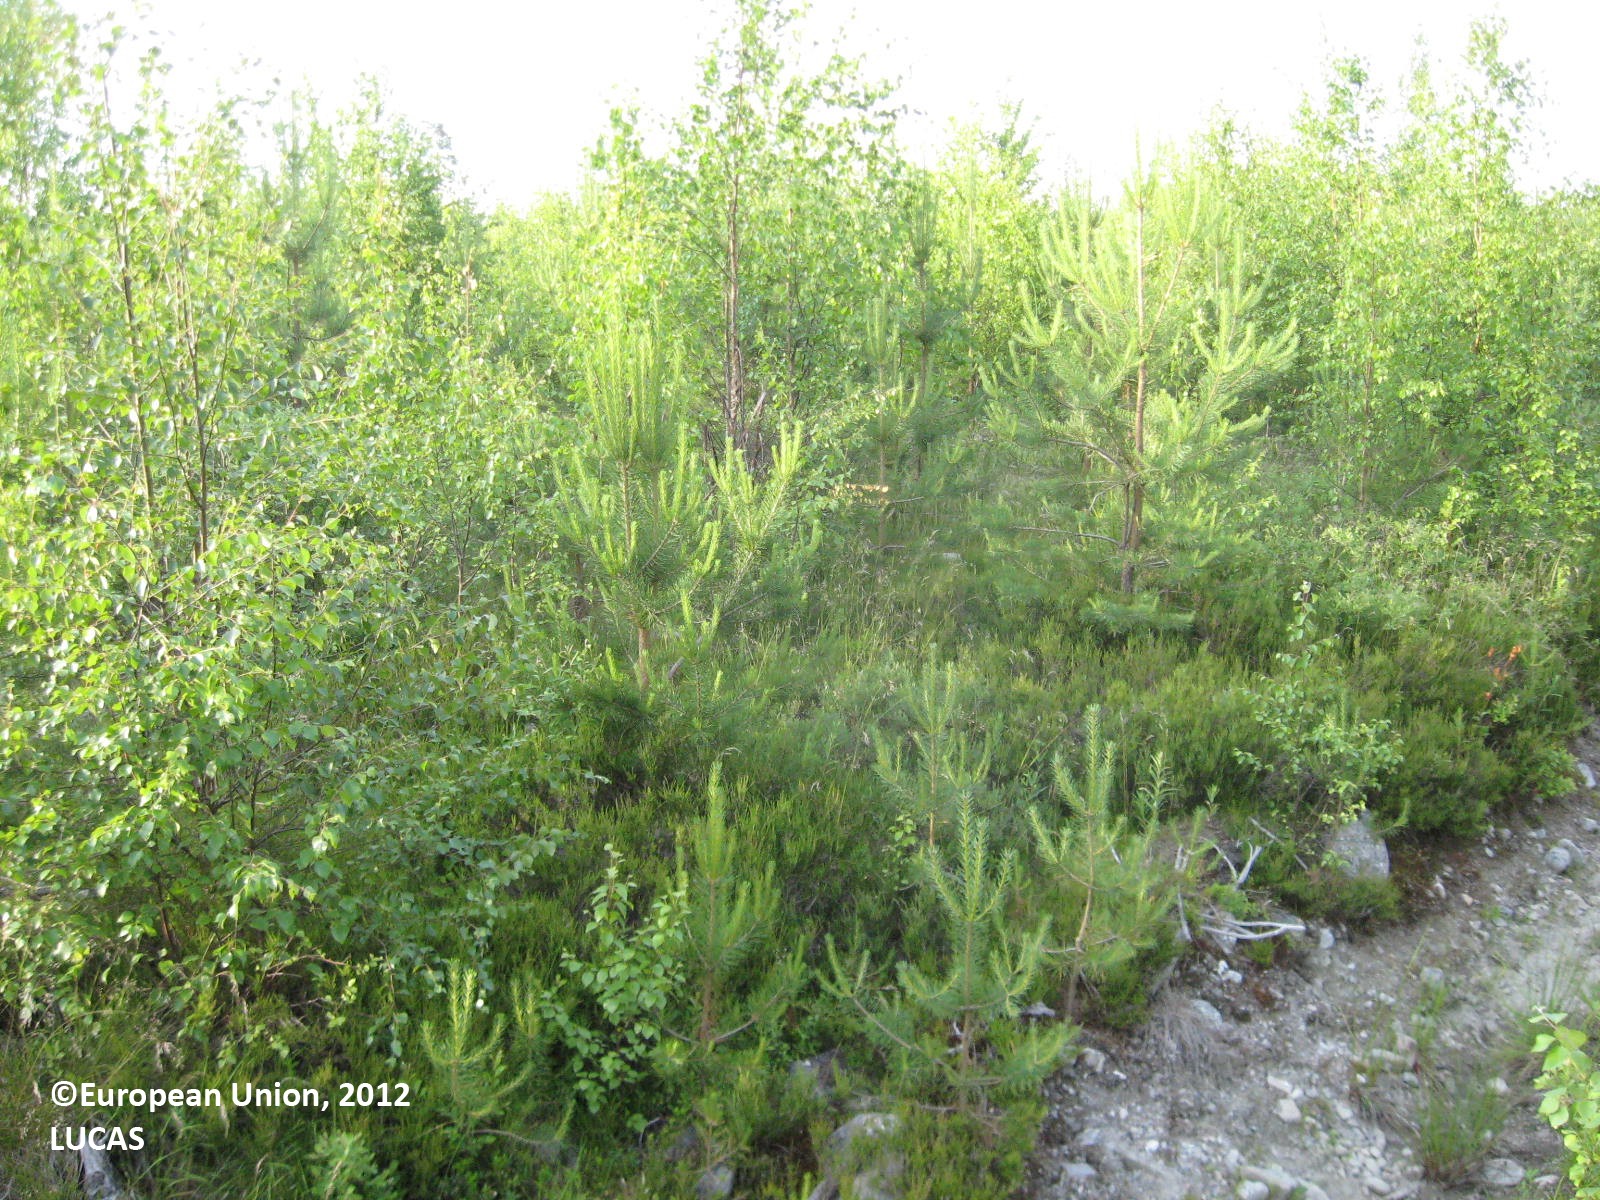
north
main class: Woodland
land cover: Pine dominated mixed woodland
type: boreal forest
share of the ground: > 75 %
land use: Forestry
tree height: < 5 m
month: July
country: FI
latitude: 62.5538
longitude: 21.7336
